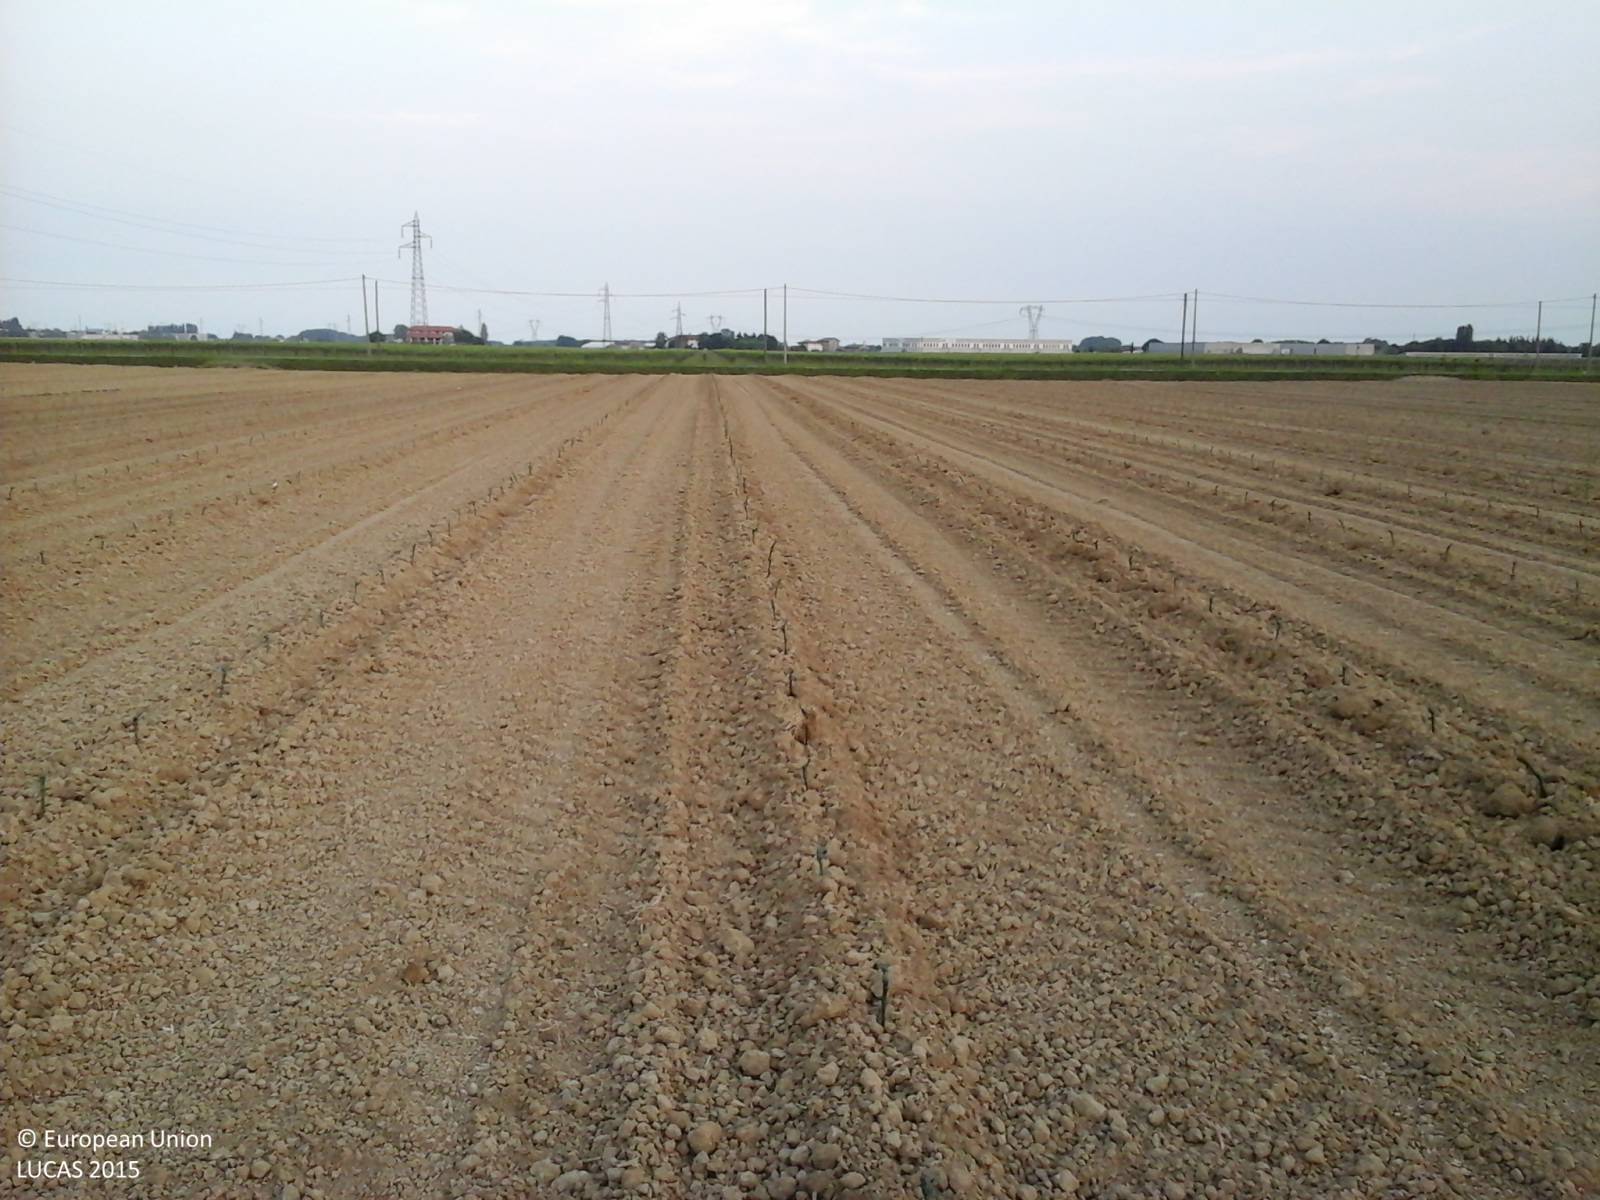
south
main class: Cropland
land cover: Vineyards
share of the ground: < 10 %
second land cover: Other bare soil
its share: > 75 %
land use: Agriculture (excluding fallow land and kitchen gardens)
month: June
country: IT
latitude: 45.8166
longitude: 13.2007
